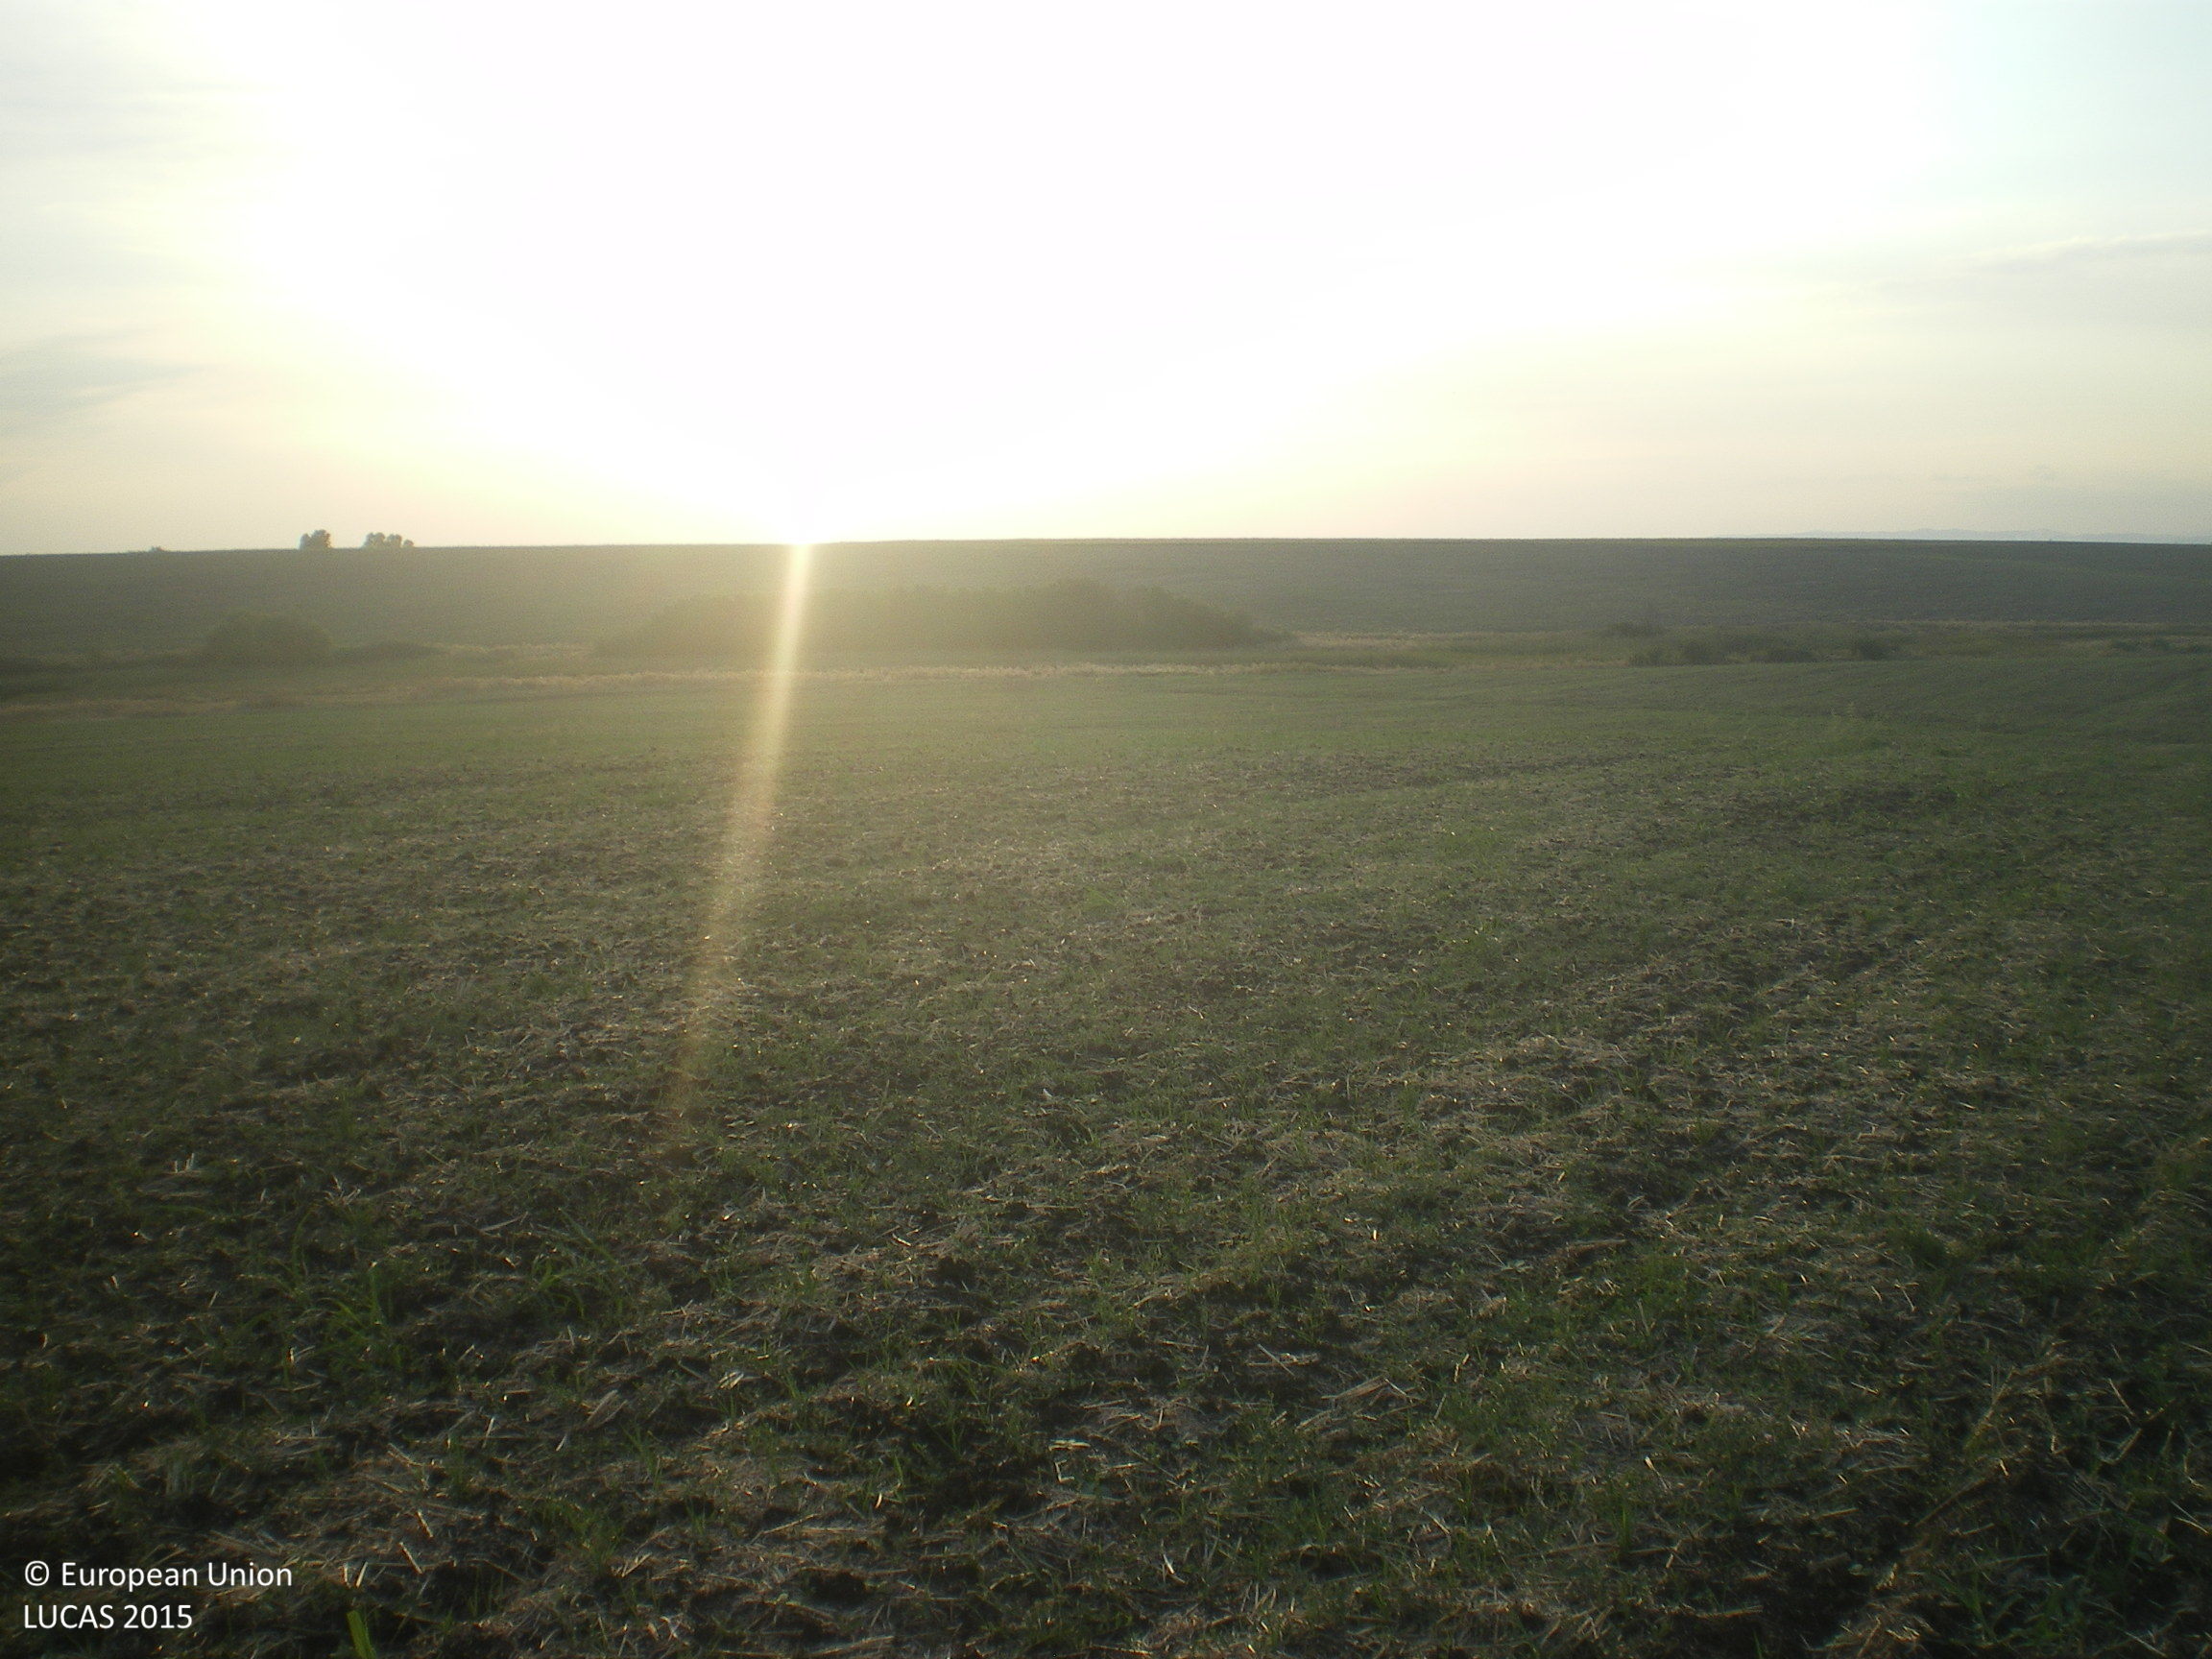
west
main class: Cropland
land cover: Common wheat
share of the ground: < 10 %
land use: Agriculture (excluding fallow land and kitchen gardens)
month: September
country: BG
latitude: 42.1588
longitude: 25.7938
